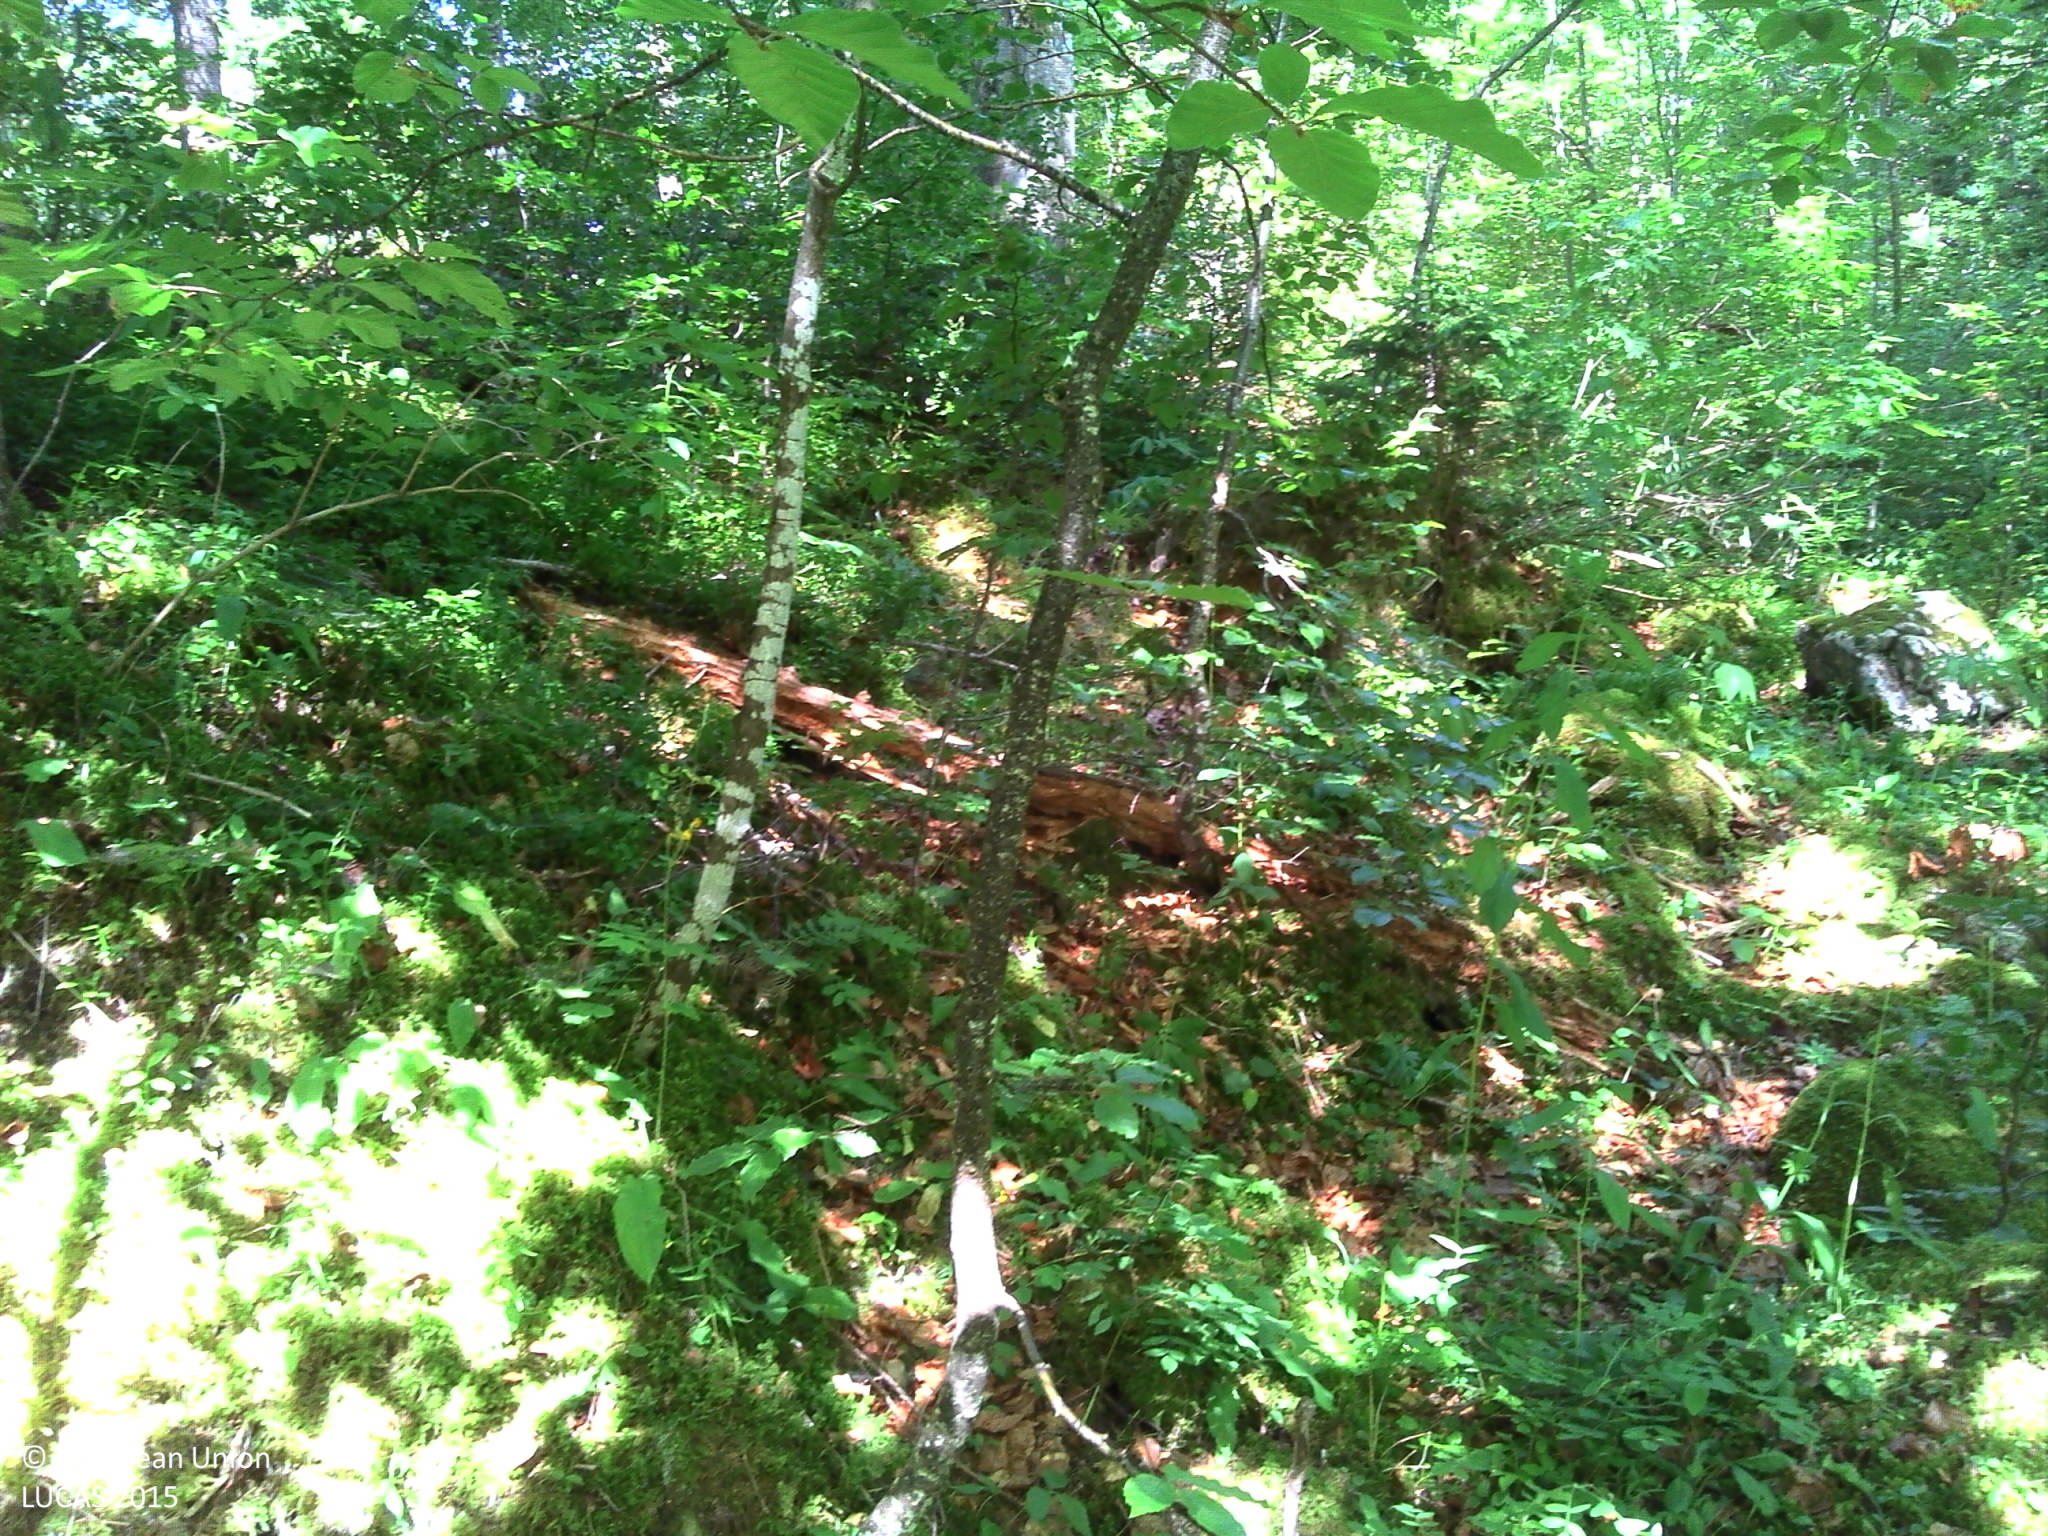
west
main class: Woodland
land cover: Spruce dominated mixed woodland
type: mountainous beech forest
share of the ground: > 75 %
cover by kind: broadleaved forest trees 35 %, coniferous forest trees 30 %, consolidated bare surface 20 %, lichens and mosses 10 %, herbaceous plants 5 %
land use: Forestry
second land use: Sport
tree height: > 5 m
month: July
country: FR
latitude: 46.5687
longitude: 6.1019
